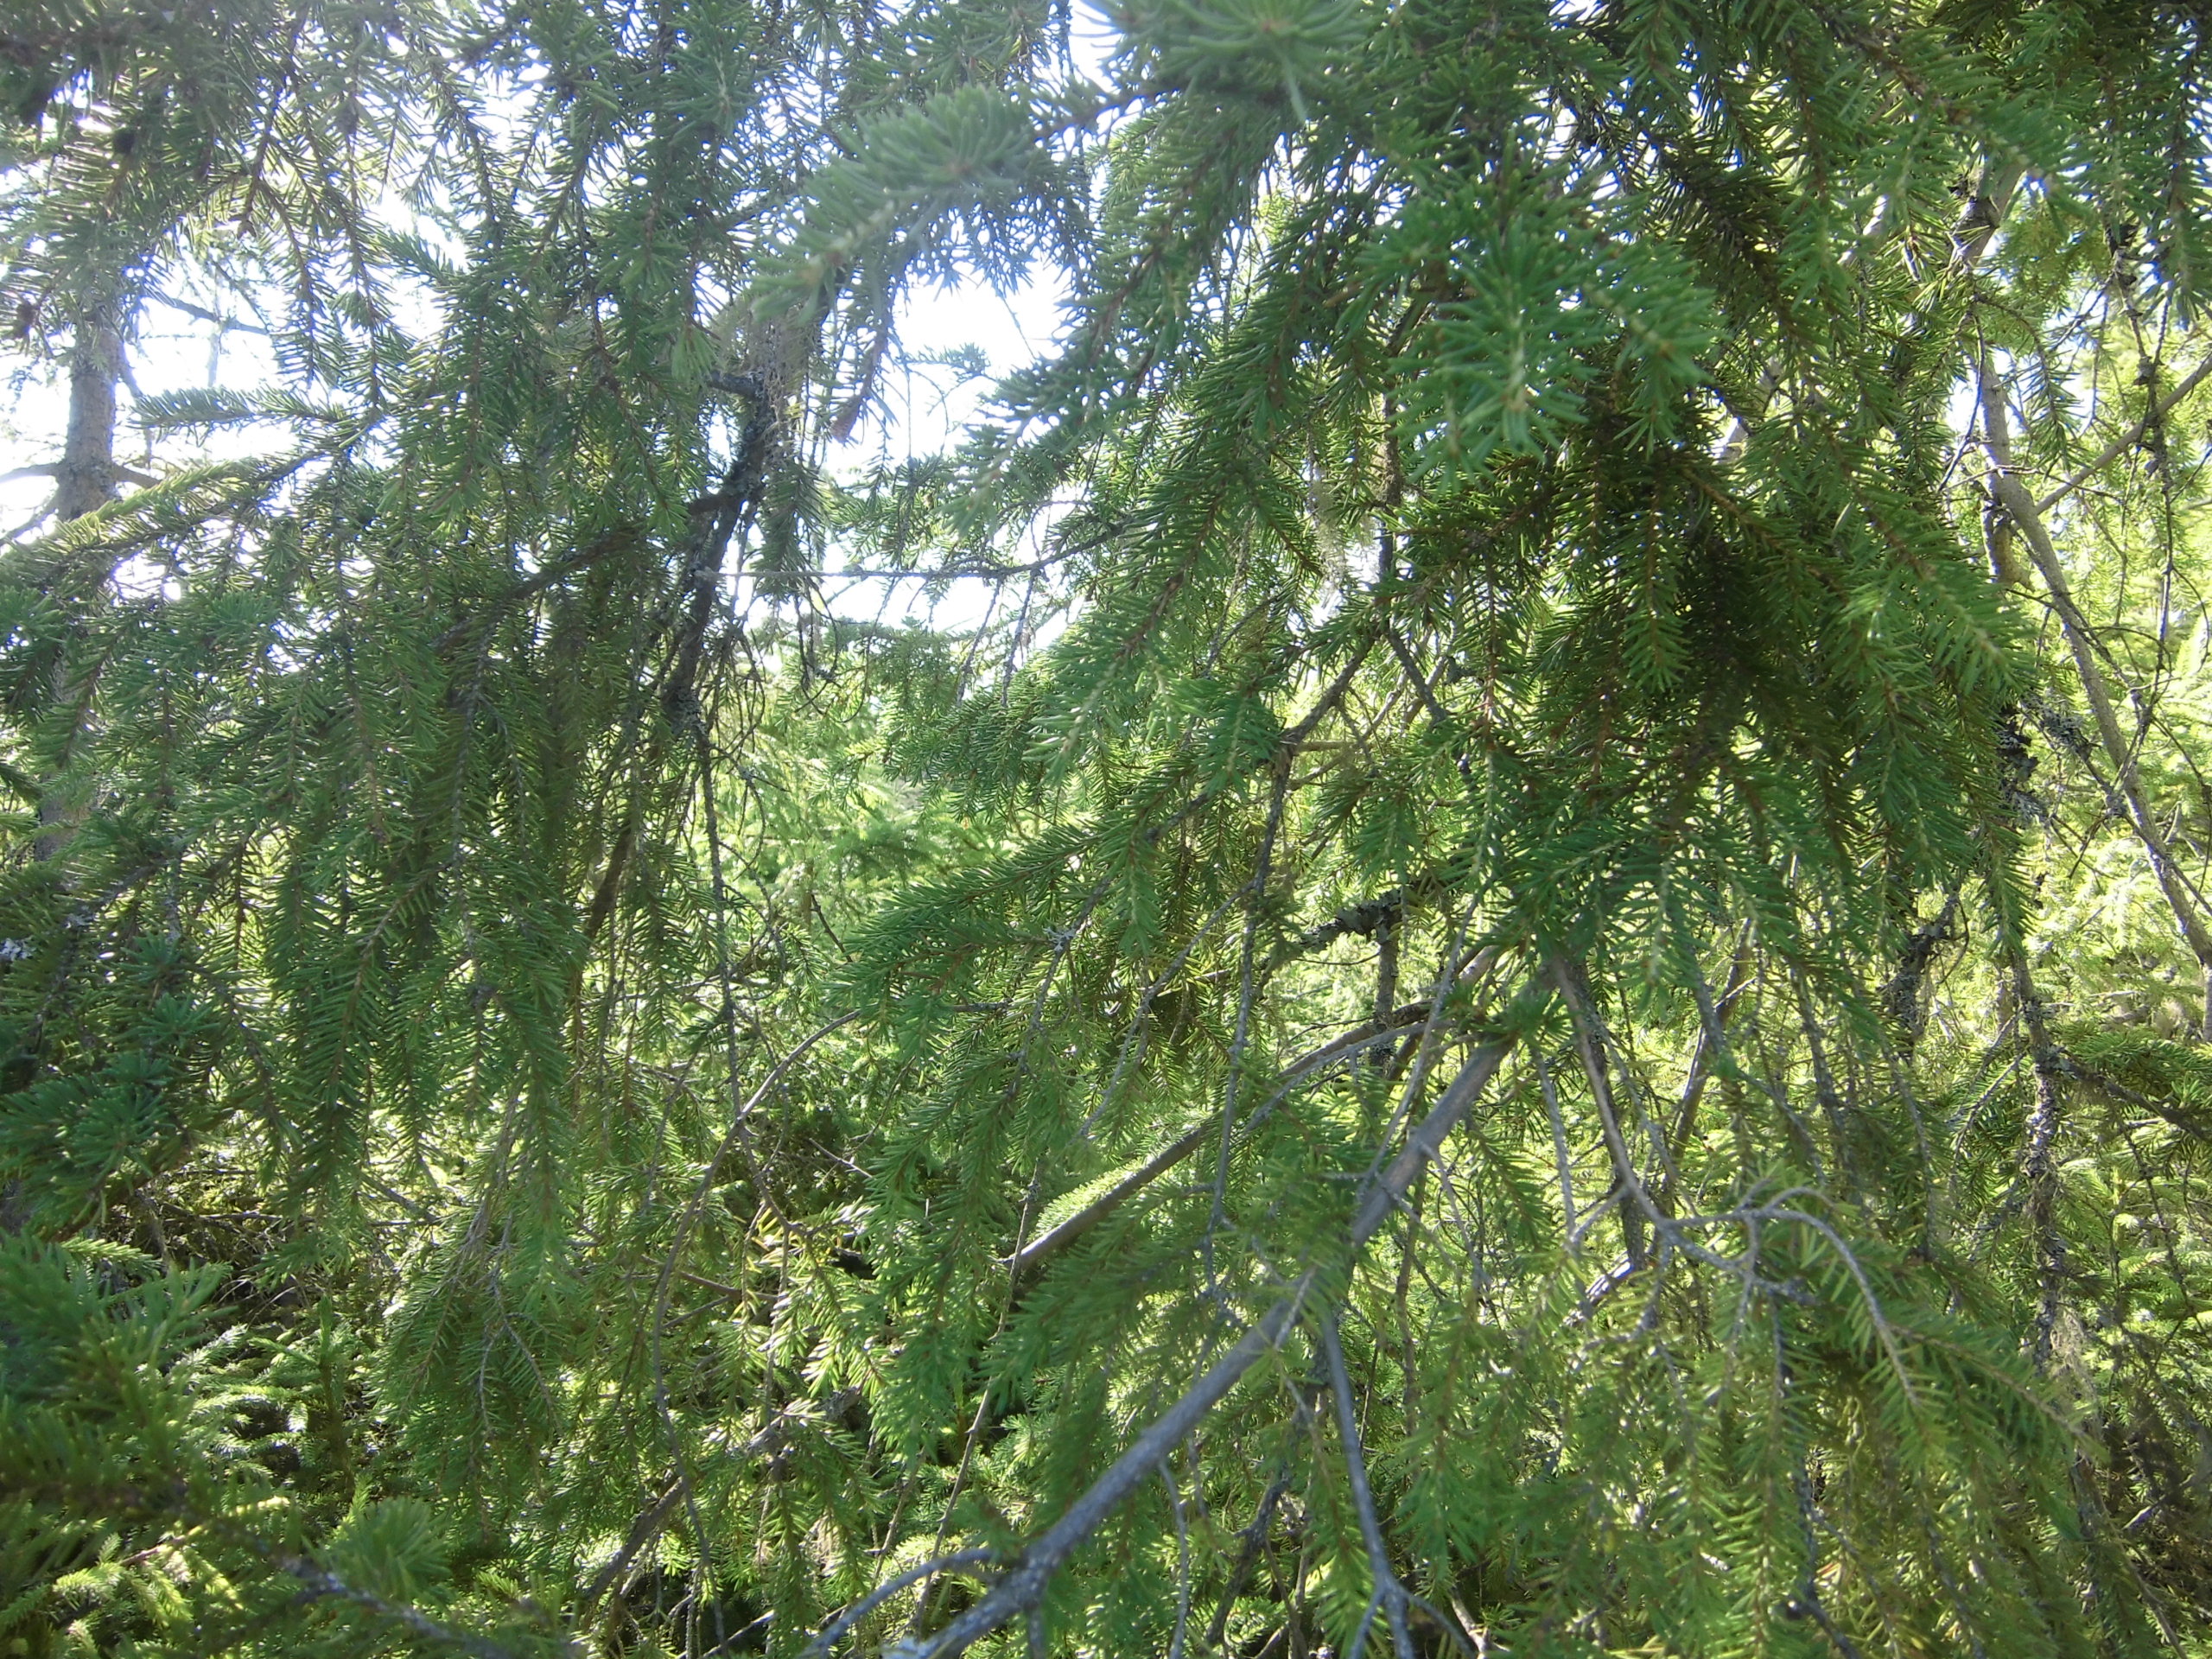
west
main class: Woodland
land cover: Spruce dominated coniferous woodland
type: boreal forest
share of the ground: > 75 %
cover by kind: coniferous forest trees 70 %, broadleaved forest trees 10 %, shrubs 10 %, herbaceous plants 10 %
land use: Forestry
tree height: > 5 m
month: July
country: SE
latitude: 57.2602
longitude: 15.4848
